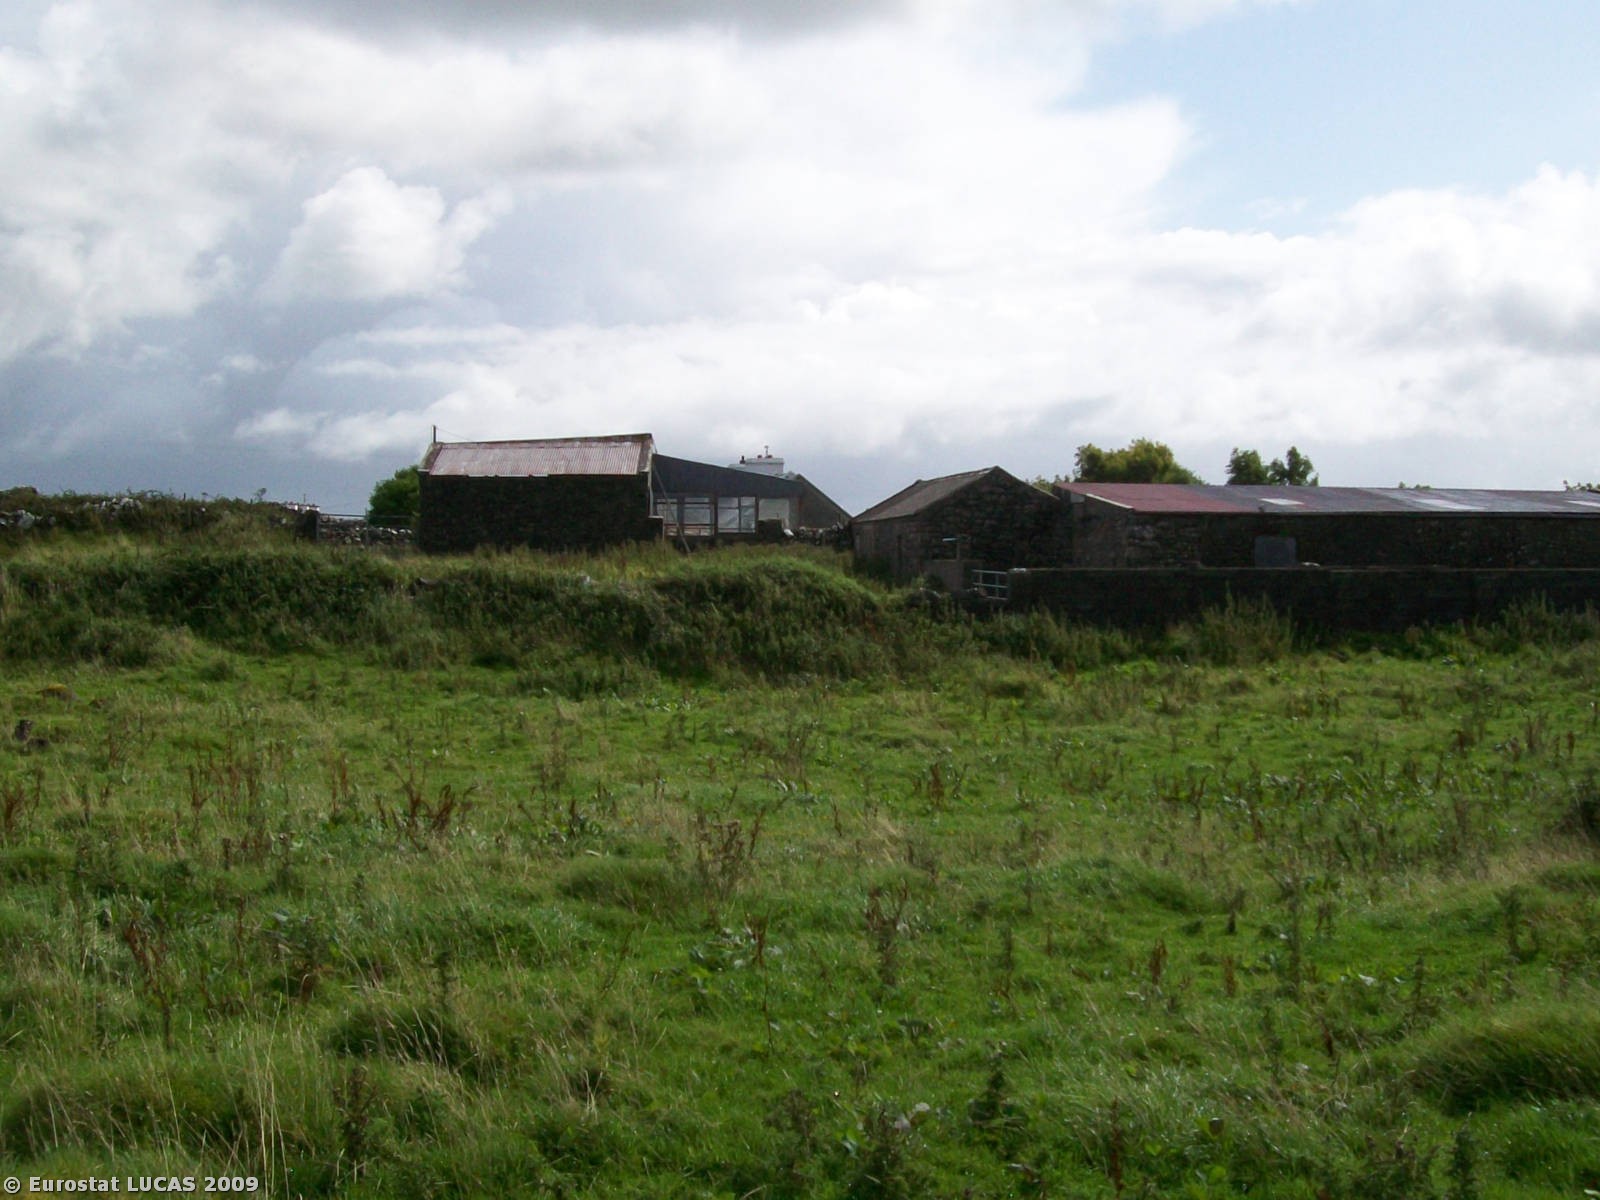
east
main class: Grassland
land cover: Grassland without tree/shrub cover
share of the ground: > 75 %
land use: Agriculture (excluding fallow land and kitchen gardens)
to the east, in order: Grassland without tree/shrub cover; Dry stone walls; Grassland without tree/shrub cover; Artificial constructions in urban areas; Grassland without tree/shrub cover; Dry stone walls; Paved roads, cycling and walking lanes; Dry stone walls; Grassland without tree/shrub cover
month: August
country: IE
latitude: 53.0361
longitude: -9.2674
